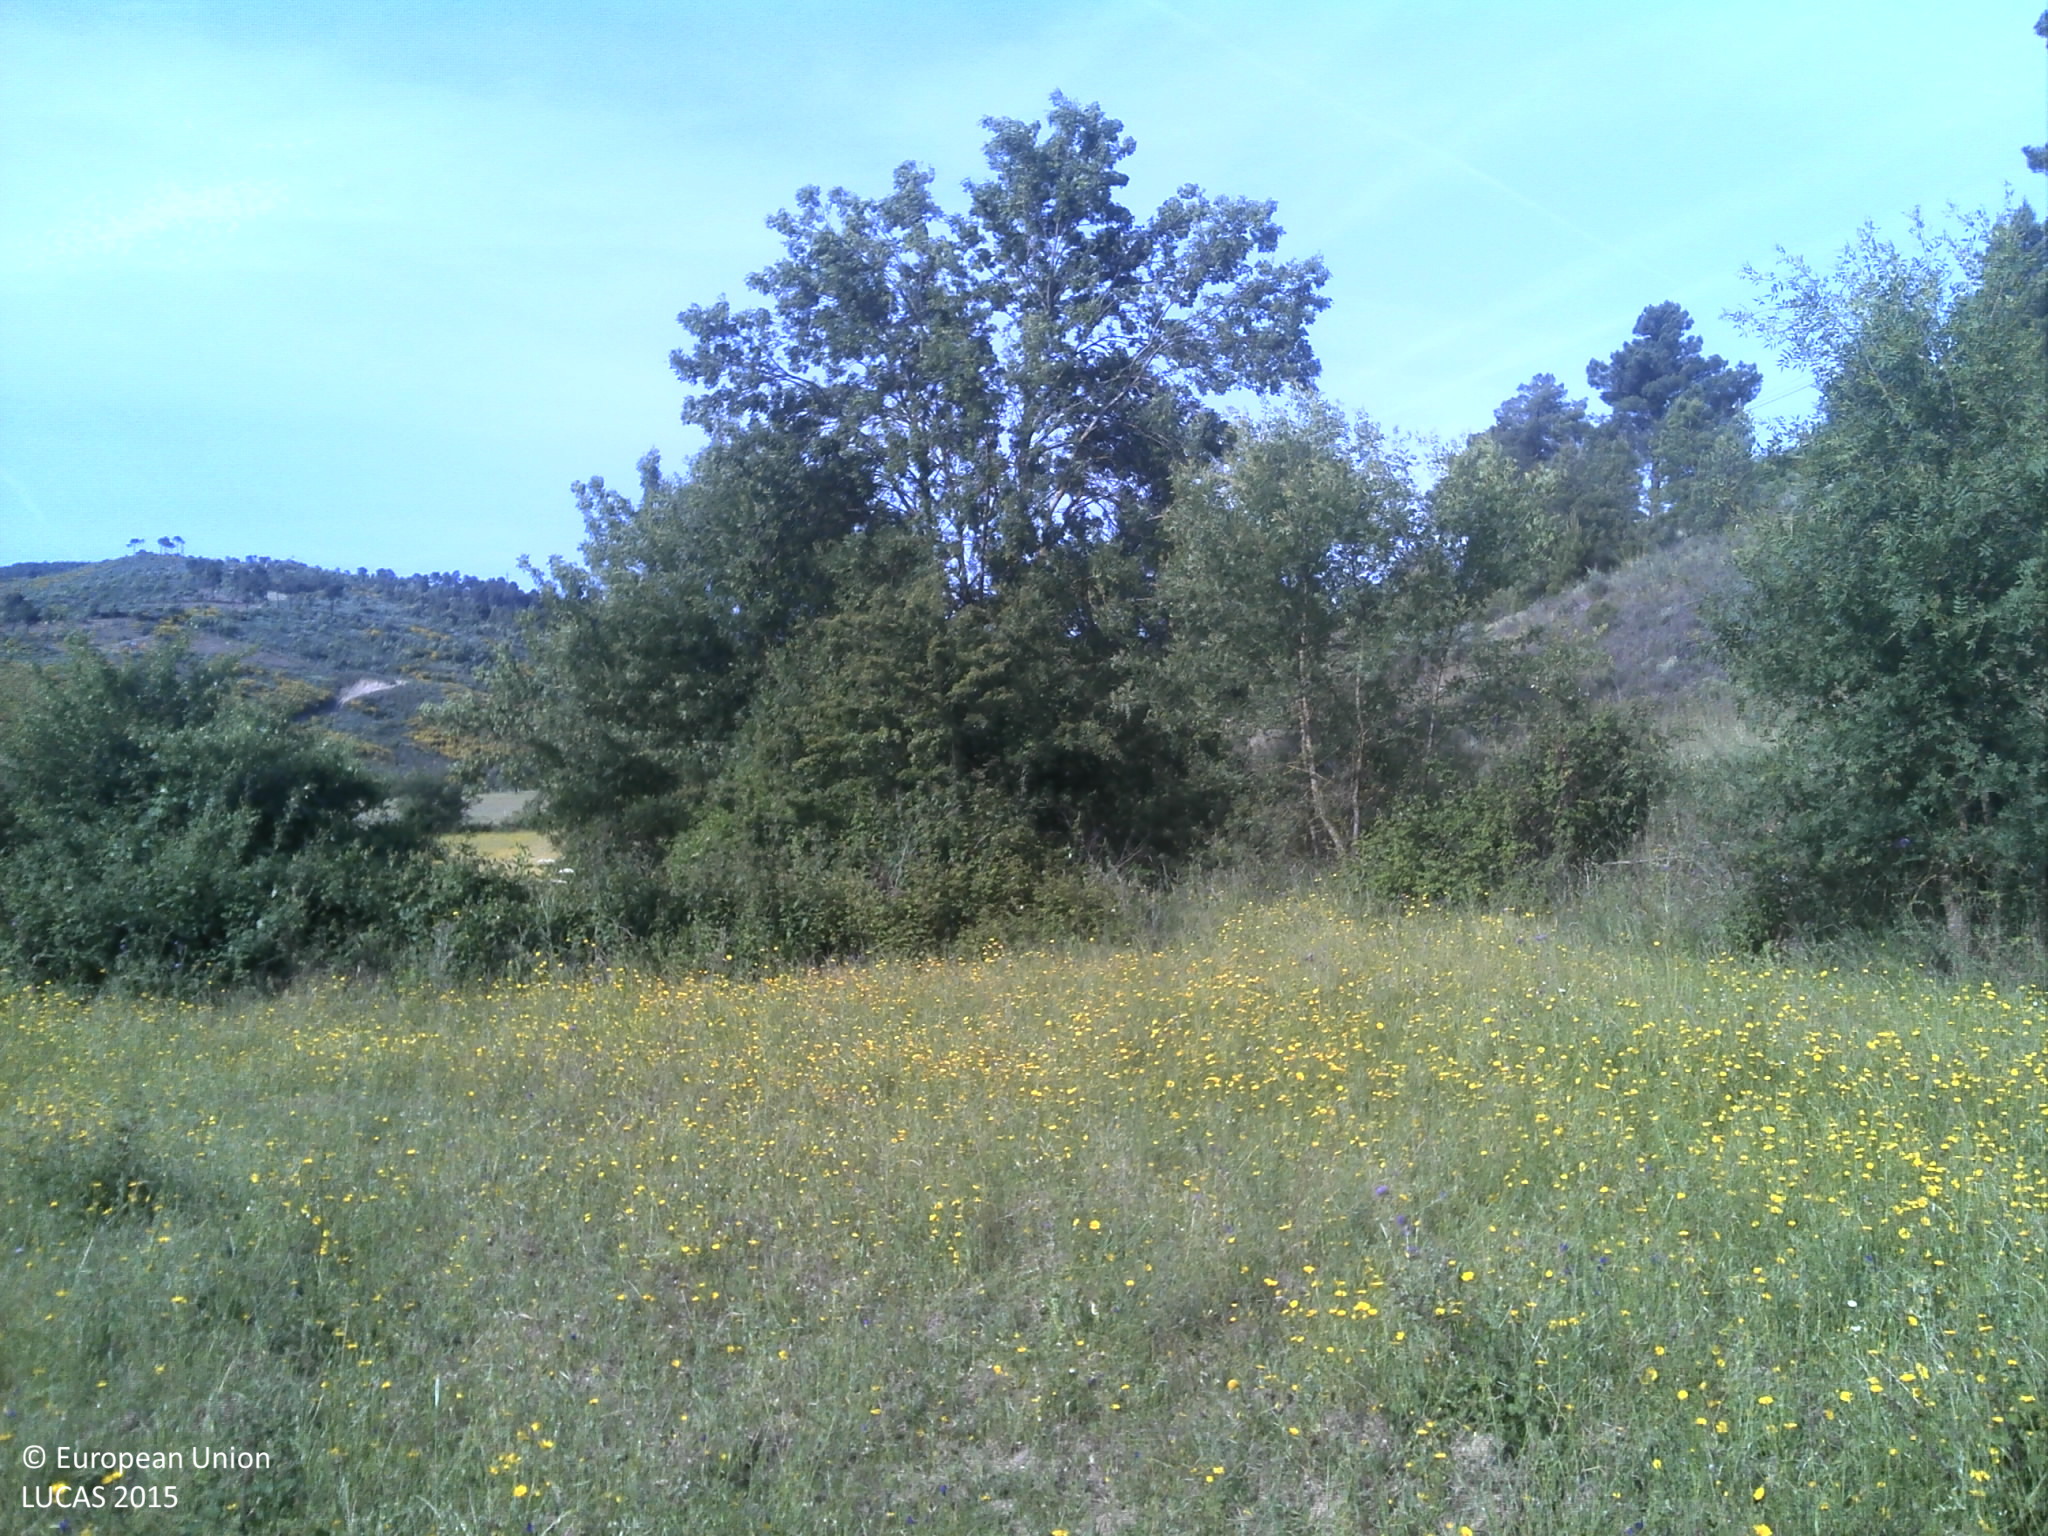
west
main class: Grassland
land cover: Grassland without tree/shrub cover
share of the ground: 50 - 75 %
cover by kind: herbaceous plants 65 %, unconsolidated bare surface 25 %
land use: Agriculture (excluding fallow land and kitchen gardens)
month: May
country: PT
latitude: 40.6173
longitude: -7.4038
